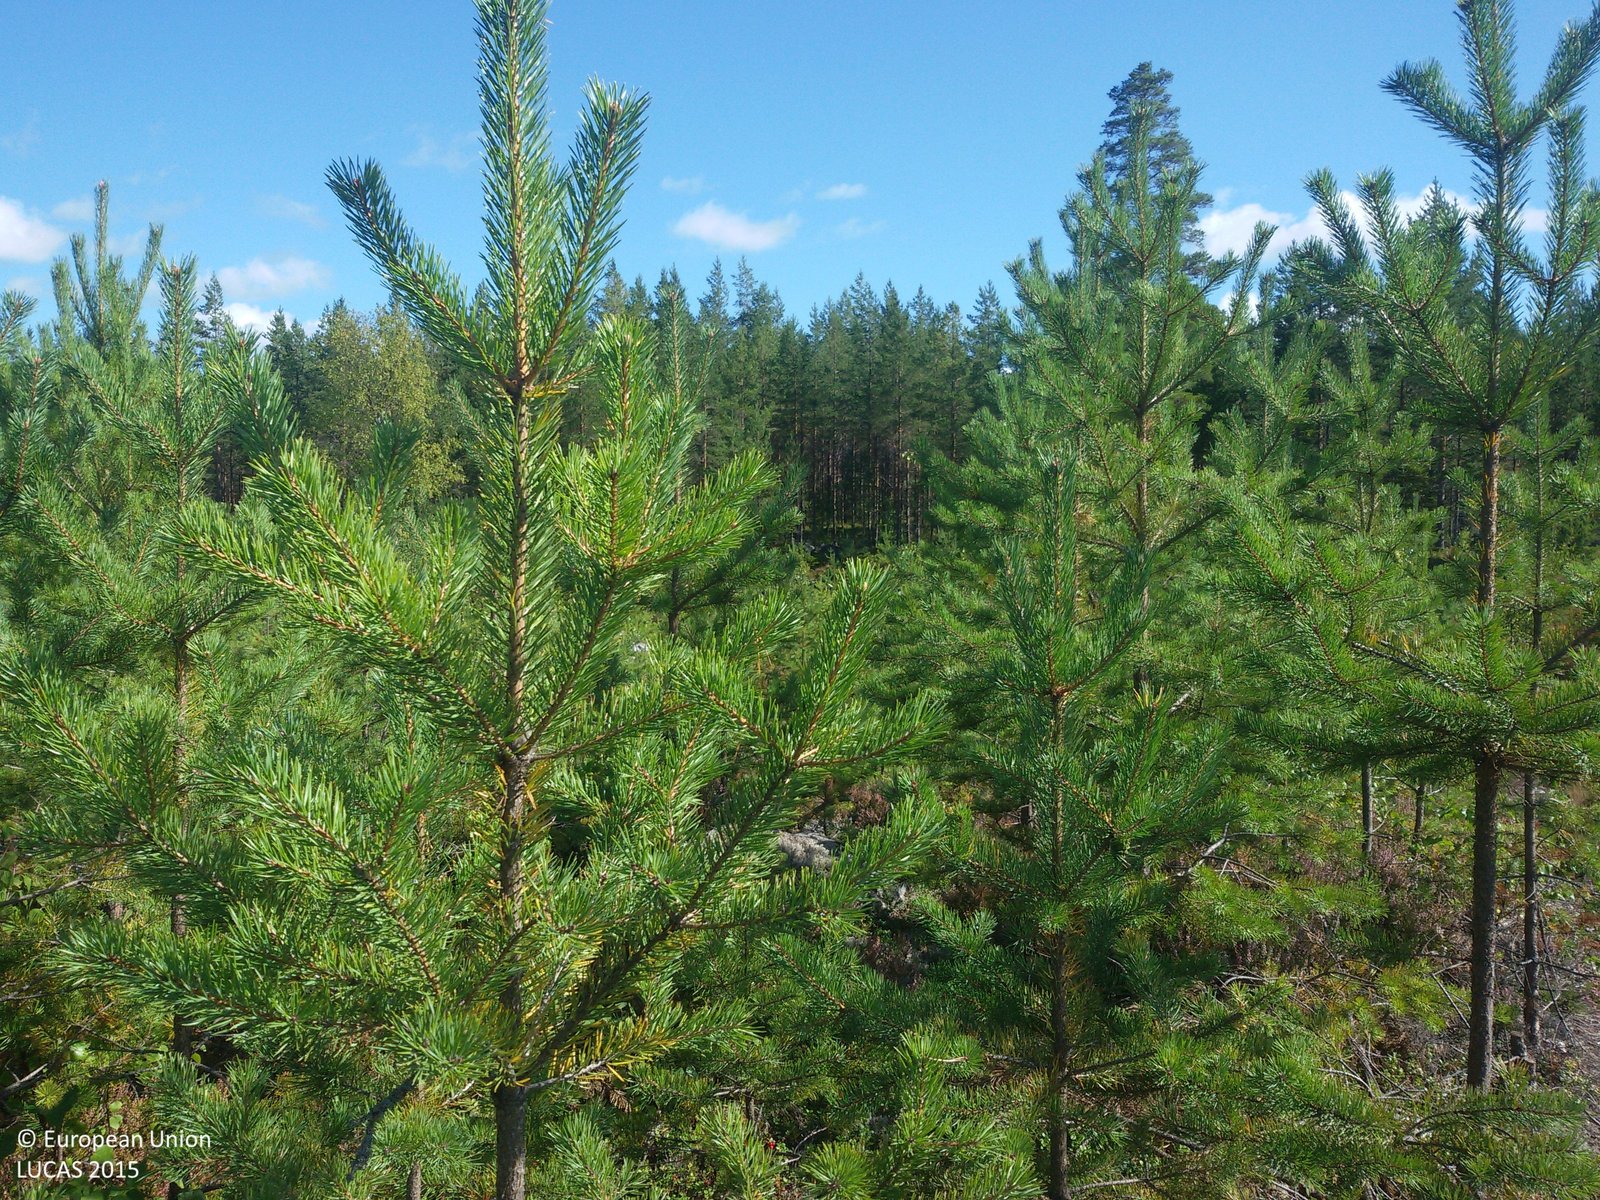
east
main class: Woodland
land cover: Pine dominated coniferous woodland
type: boreal forest
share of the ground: 50 - 75 %
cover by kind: coniferous forest trees 60 %, herbaceous plants 20 %, broadleaved forest trees 10 %, lichens and mosses 10 %
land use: Forestry
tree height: < 5 m
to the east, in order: Pine dominated coniferous woodland
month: August
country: SE
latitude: 60.6608
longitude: 15.7139
